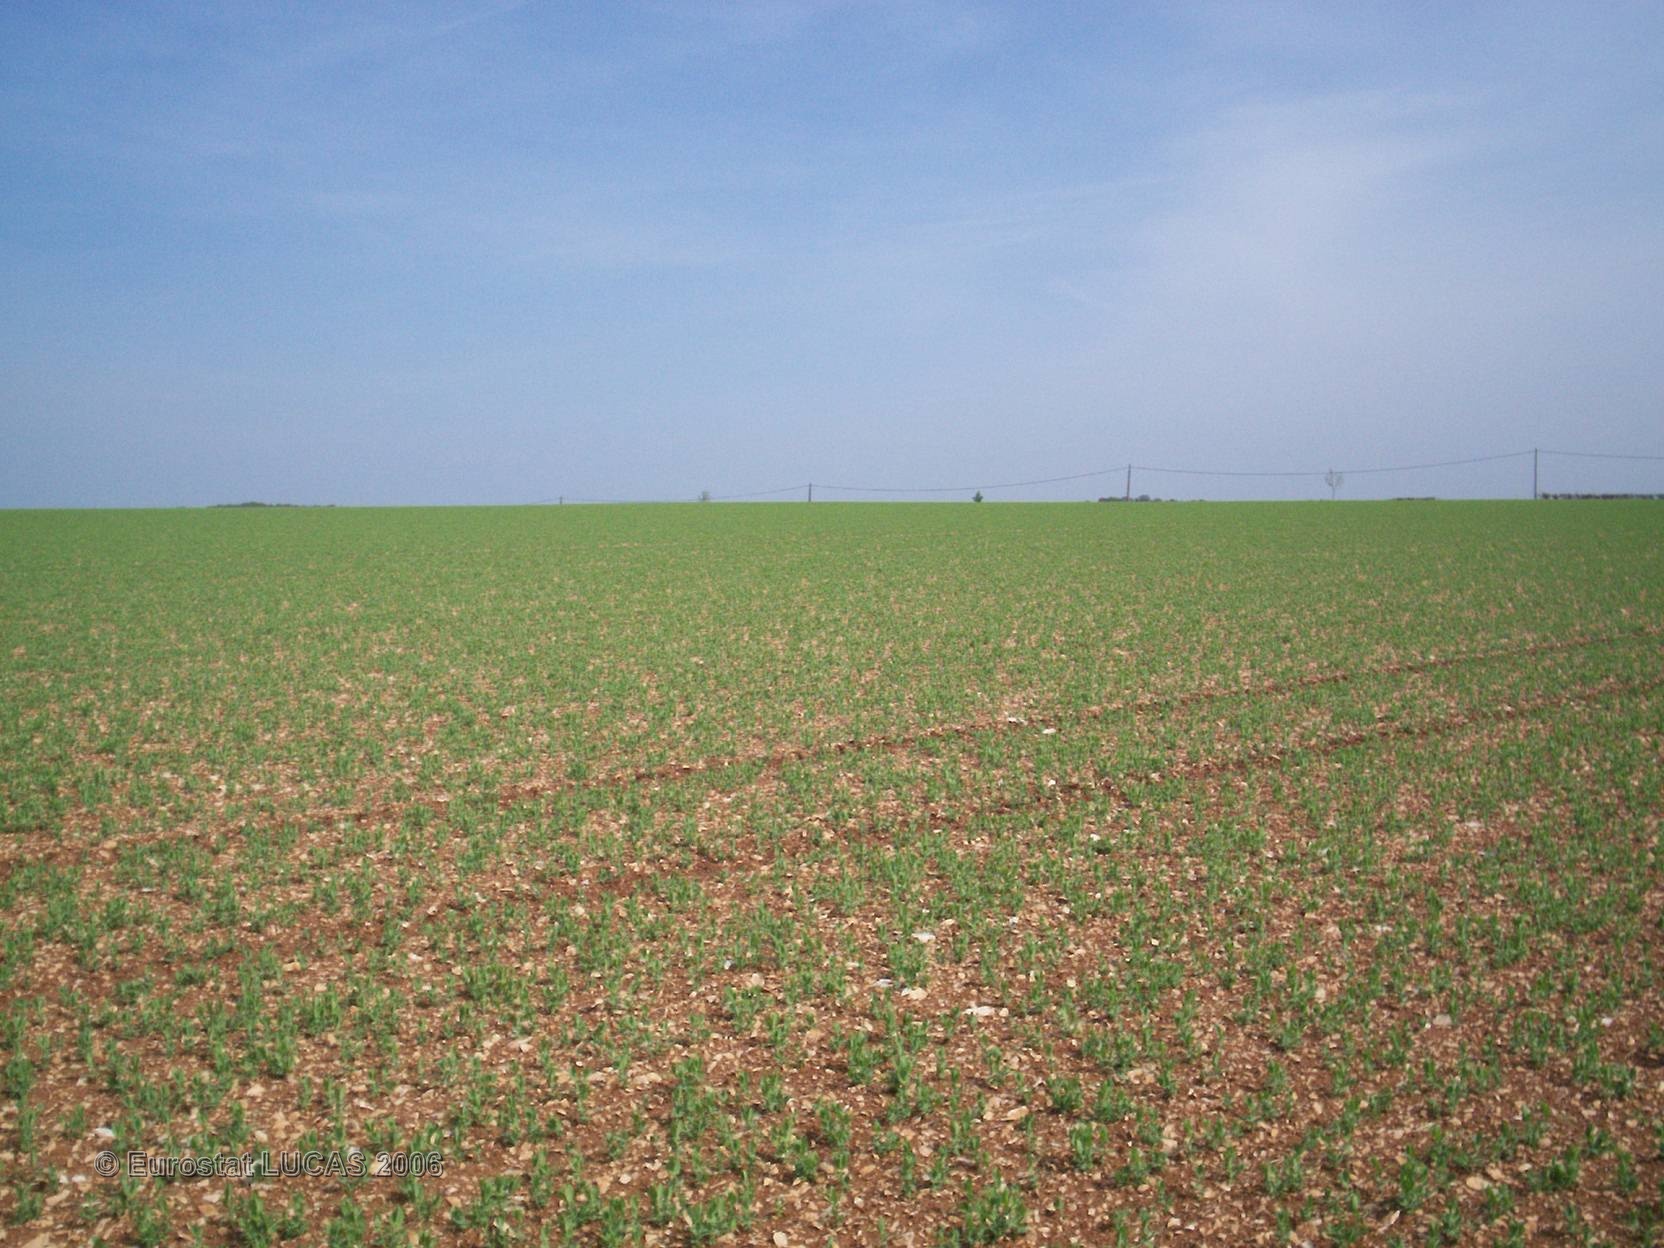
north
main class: Cropland
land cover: Dry pulses
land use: Agriculture (excluding fallow land and kitchen gardens)
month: May
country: FR
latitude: 47.6228
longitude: 4.6101
